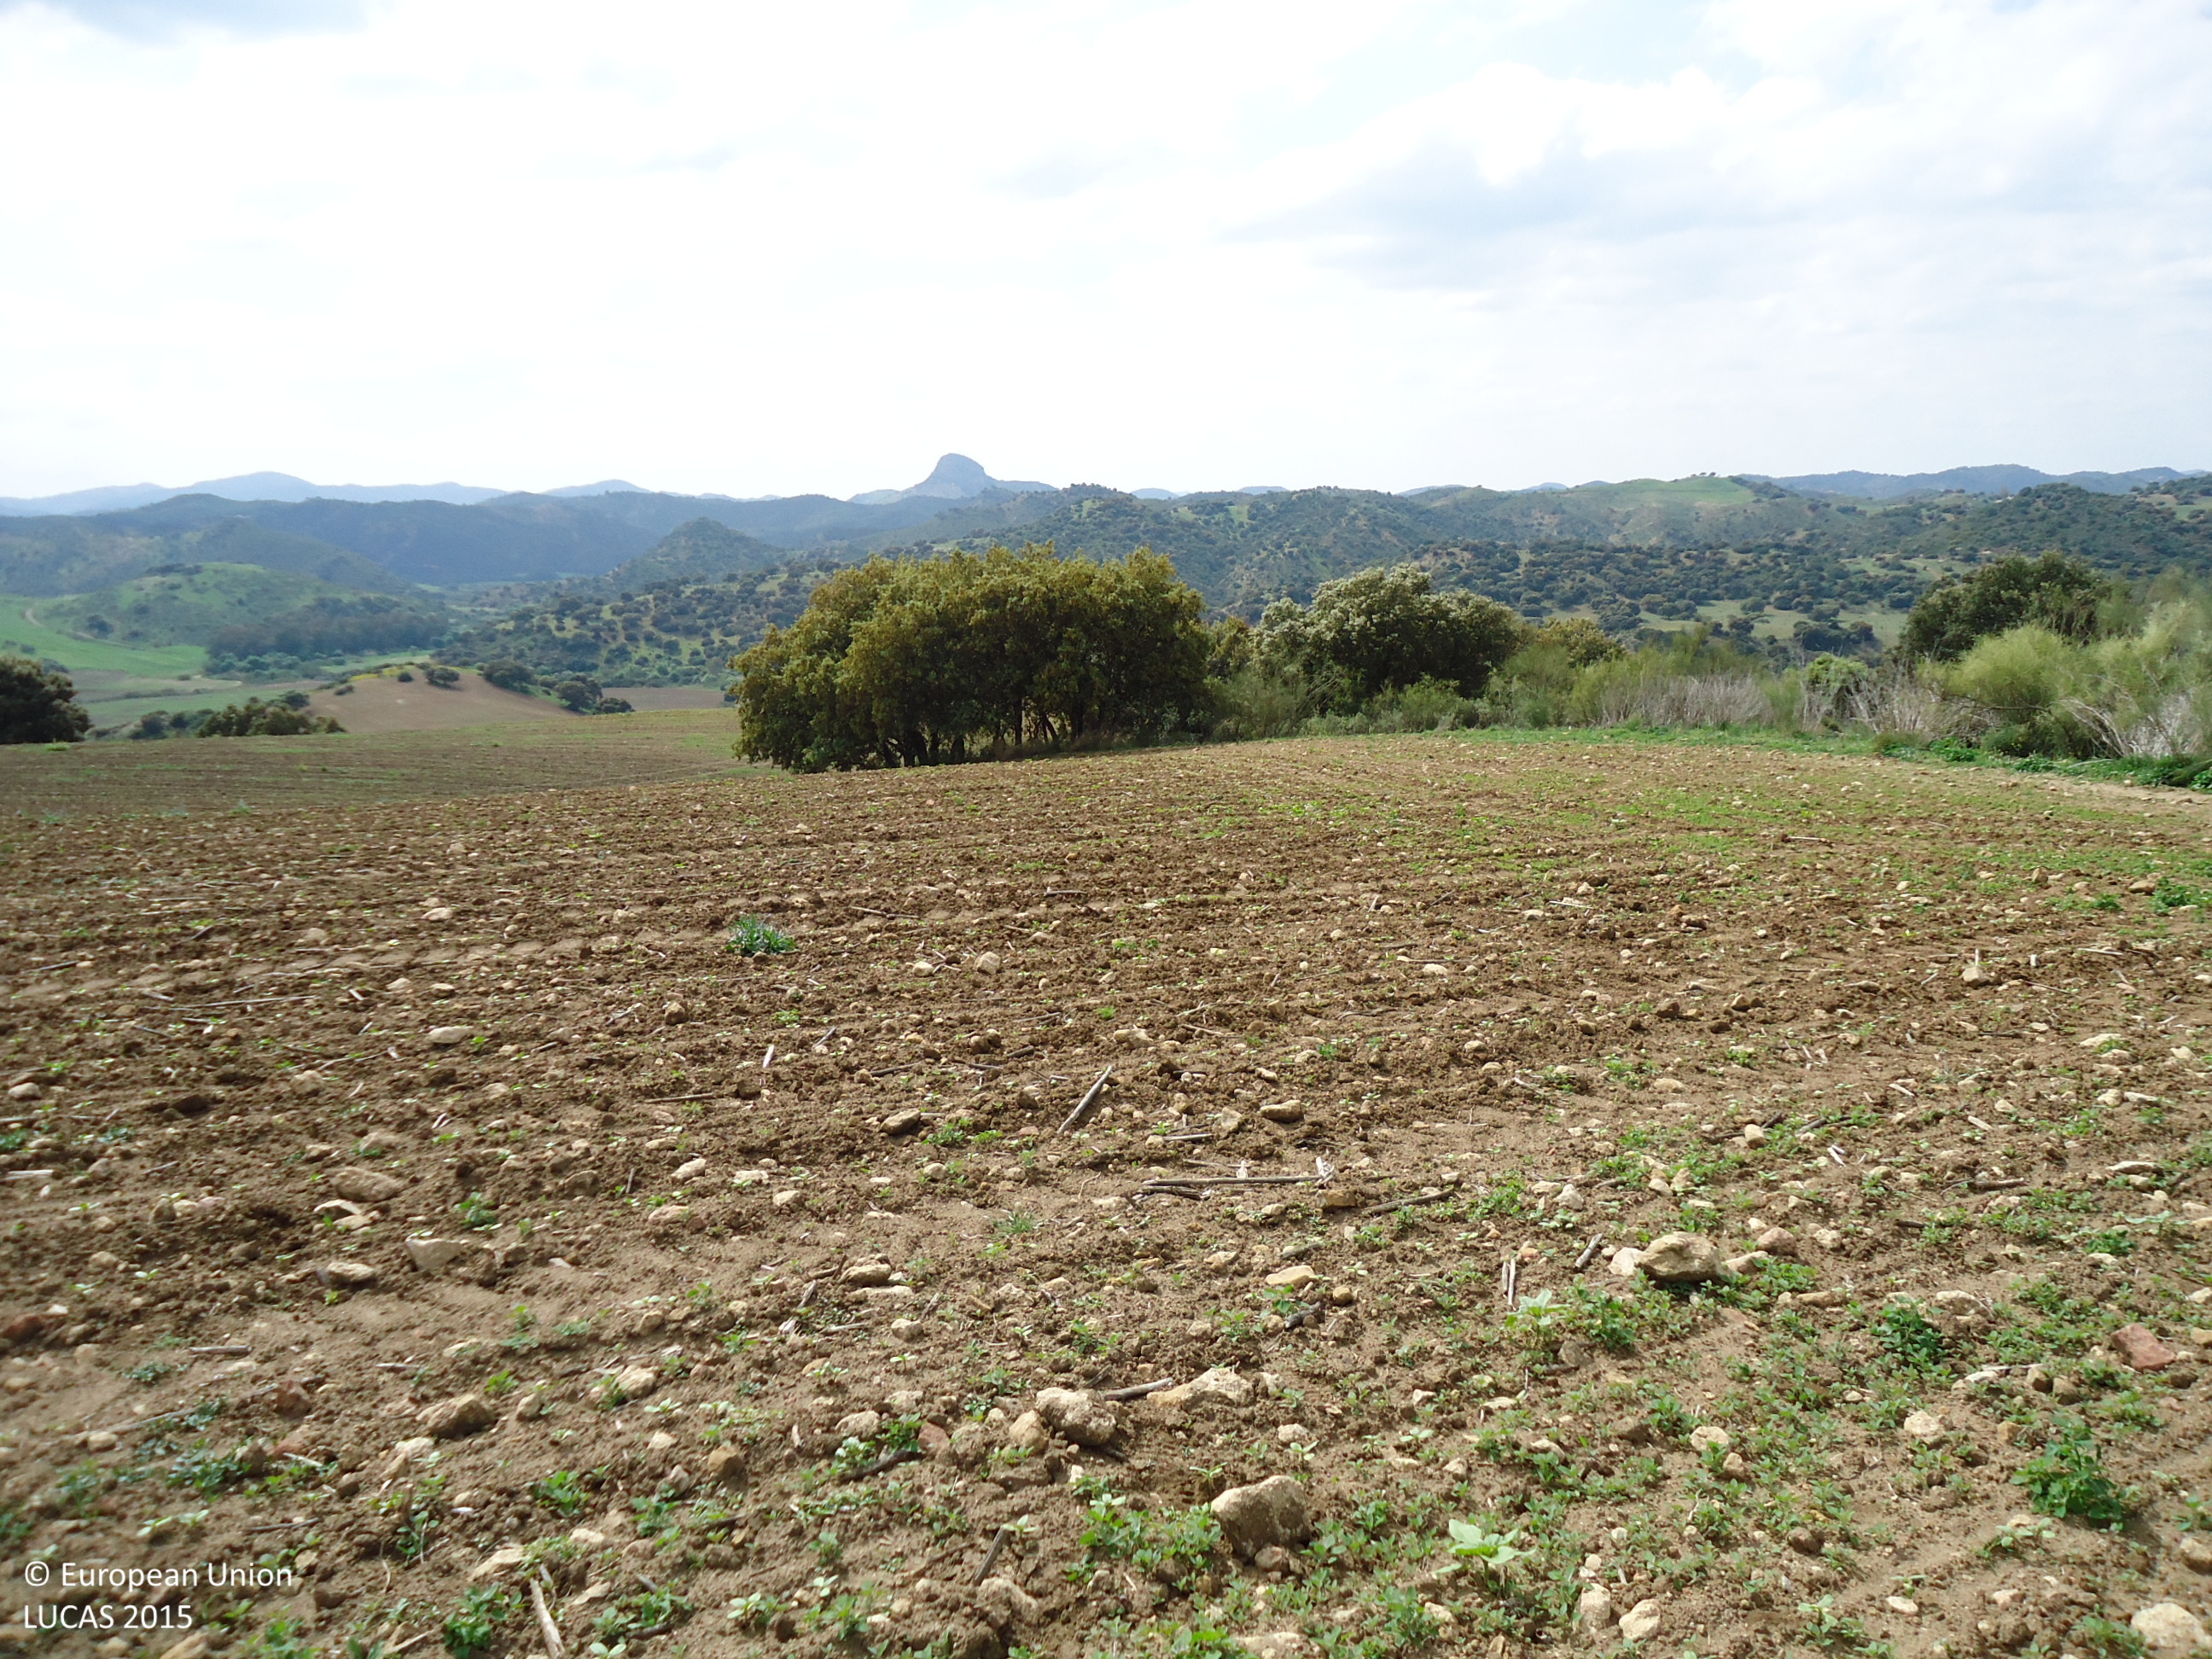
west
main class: Cropland
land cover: Sunflower
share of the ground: < 10 %
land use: Agriculture (excluding fallow land and kitchen gardens)
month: April
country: ES
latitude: 36.9811
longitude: -5.2952
